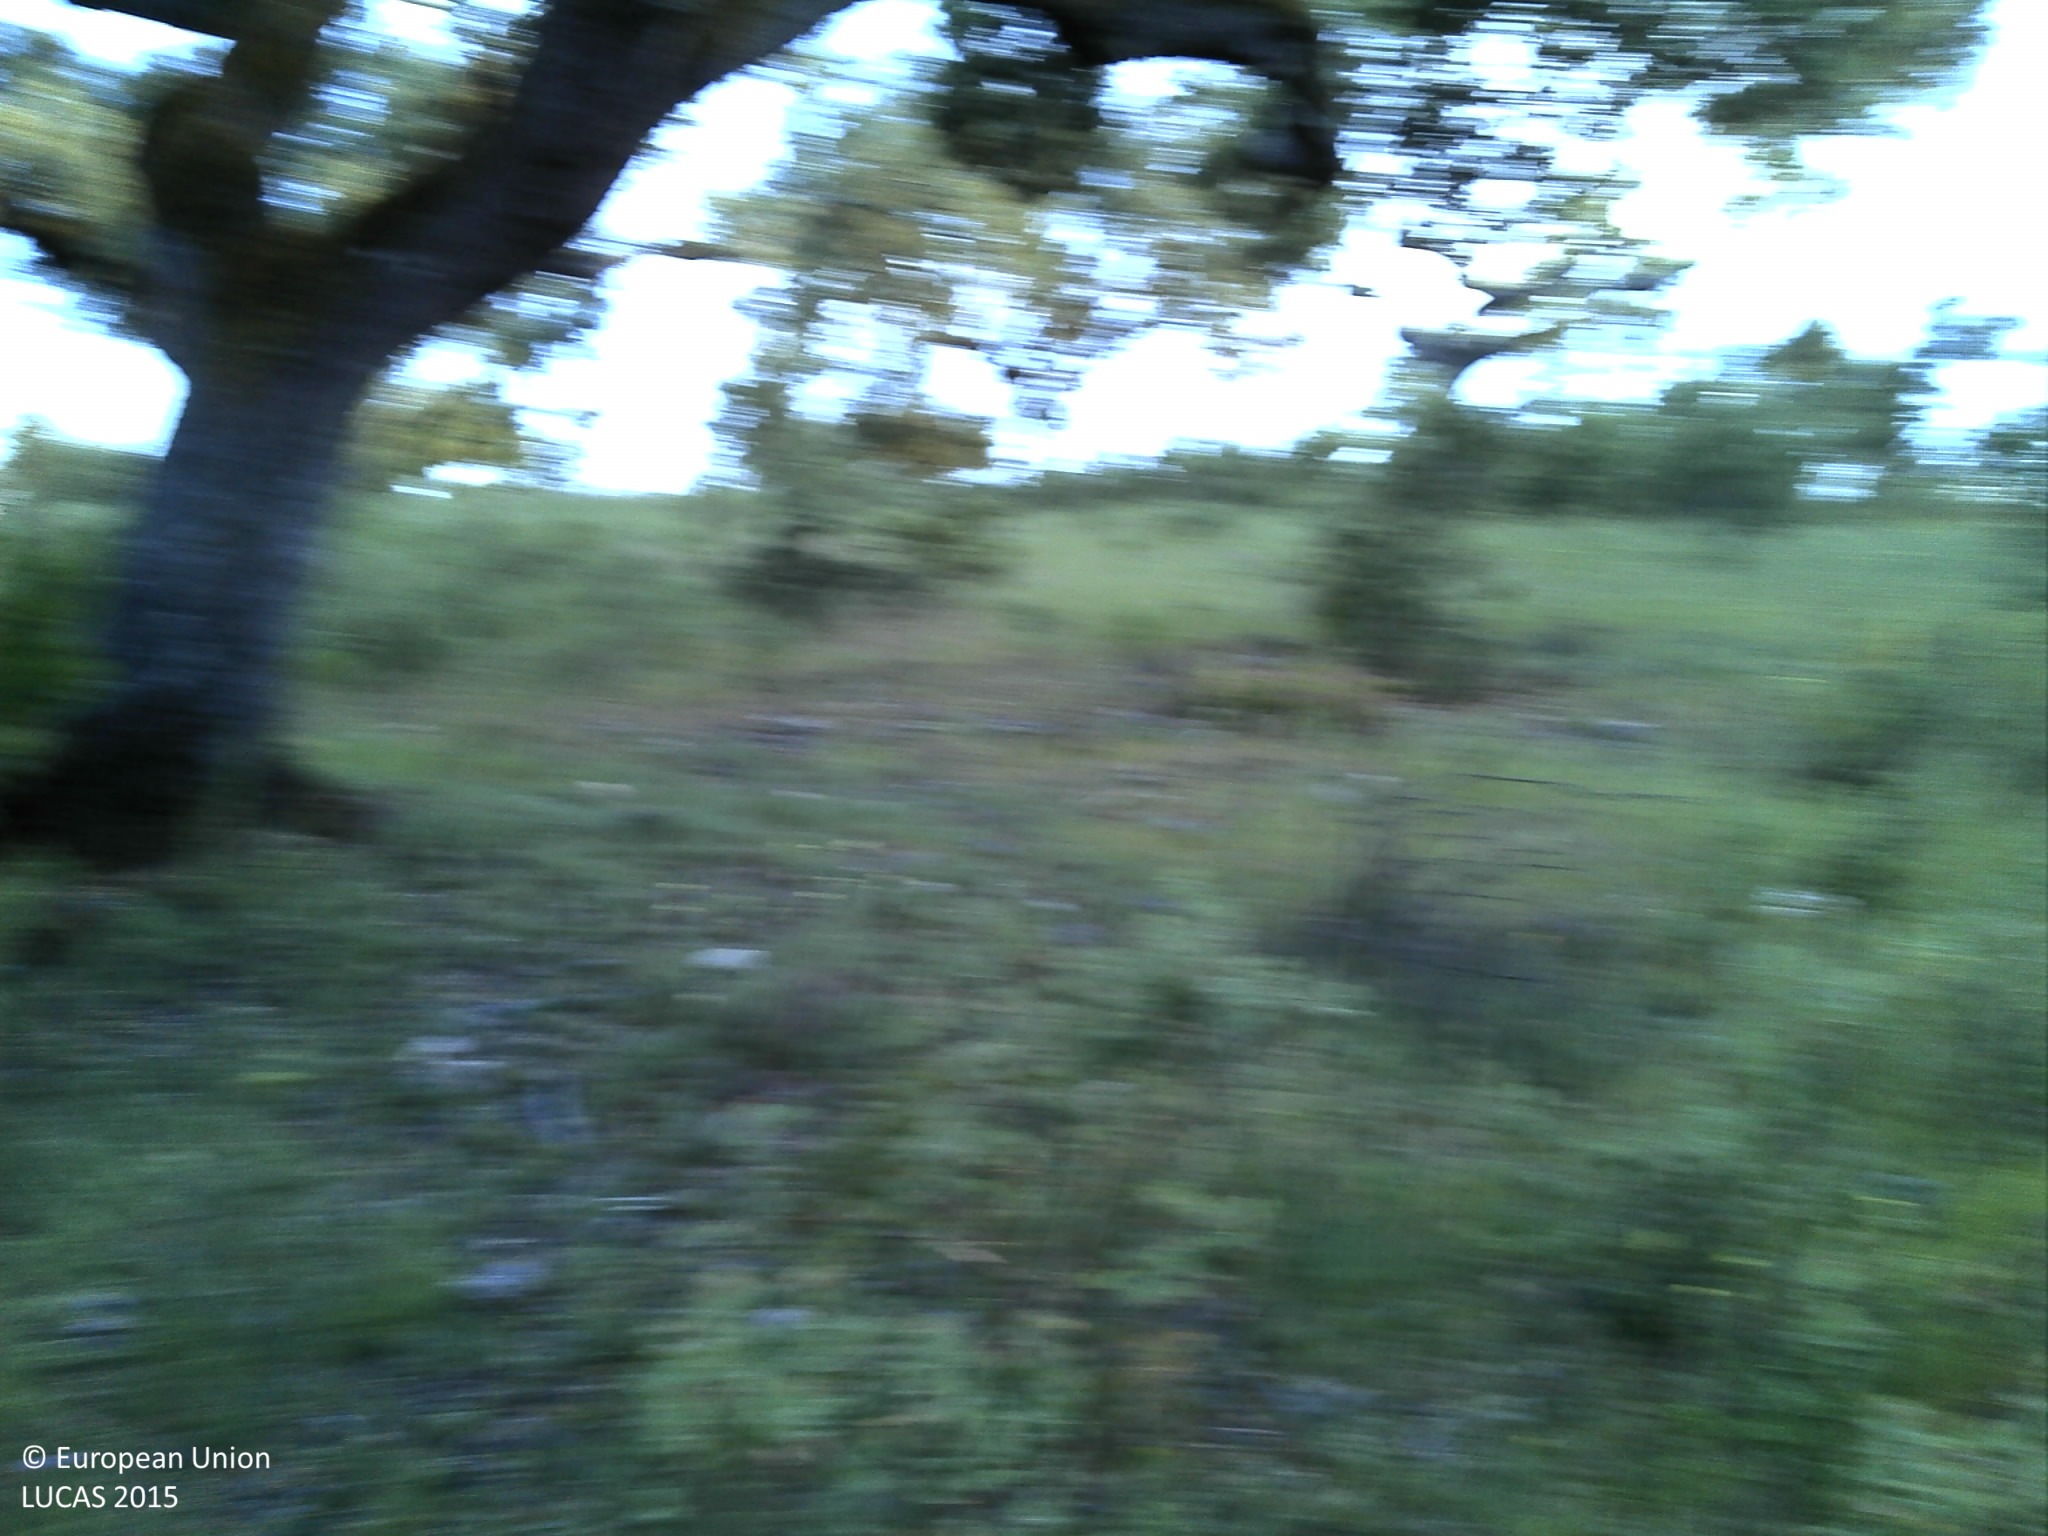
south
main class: Woodland
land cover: Broadleaved woodland
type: broadleaved evergreen forest
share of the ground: 25 - 50 %
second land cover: Grassland without tree/shrub cover
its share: 50 - 75 %
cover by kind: herbaceous plants 50 %, broadleaved forest trees 30 %, unconsolidated bare surface 15 %, shrubs 5 %
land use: Forestry
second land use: Agriculture (excluding fallow land and kitchen gardens)
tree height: > 5 m
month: May
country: PT
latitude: 39.1063
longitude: -7.8925
